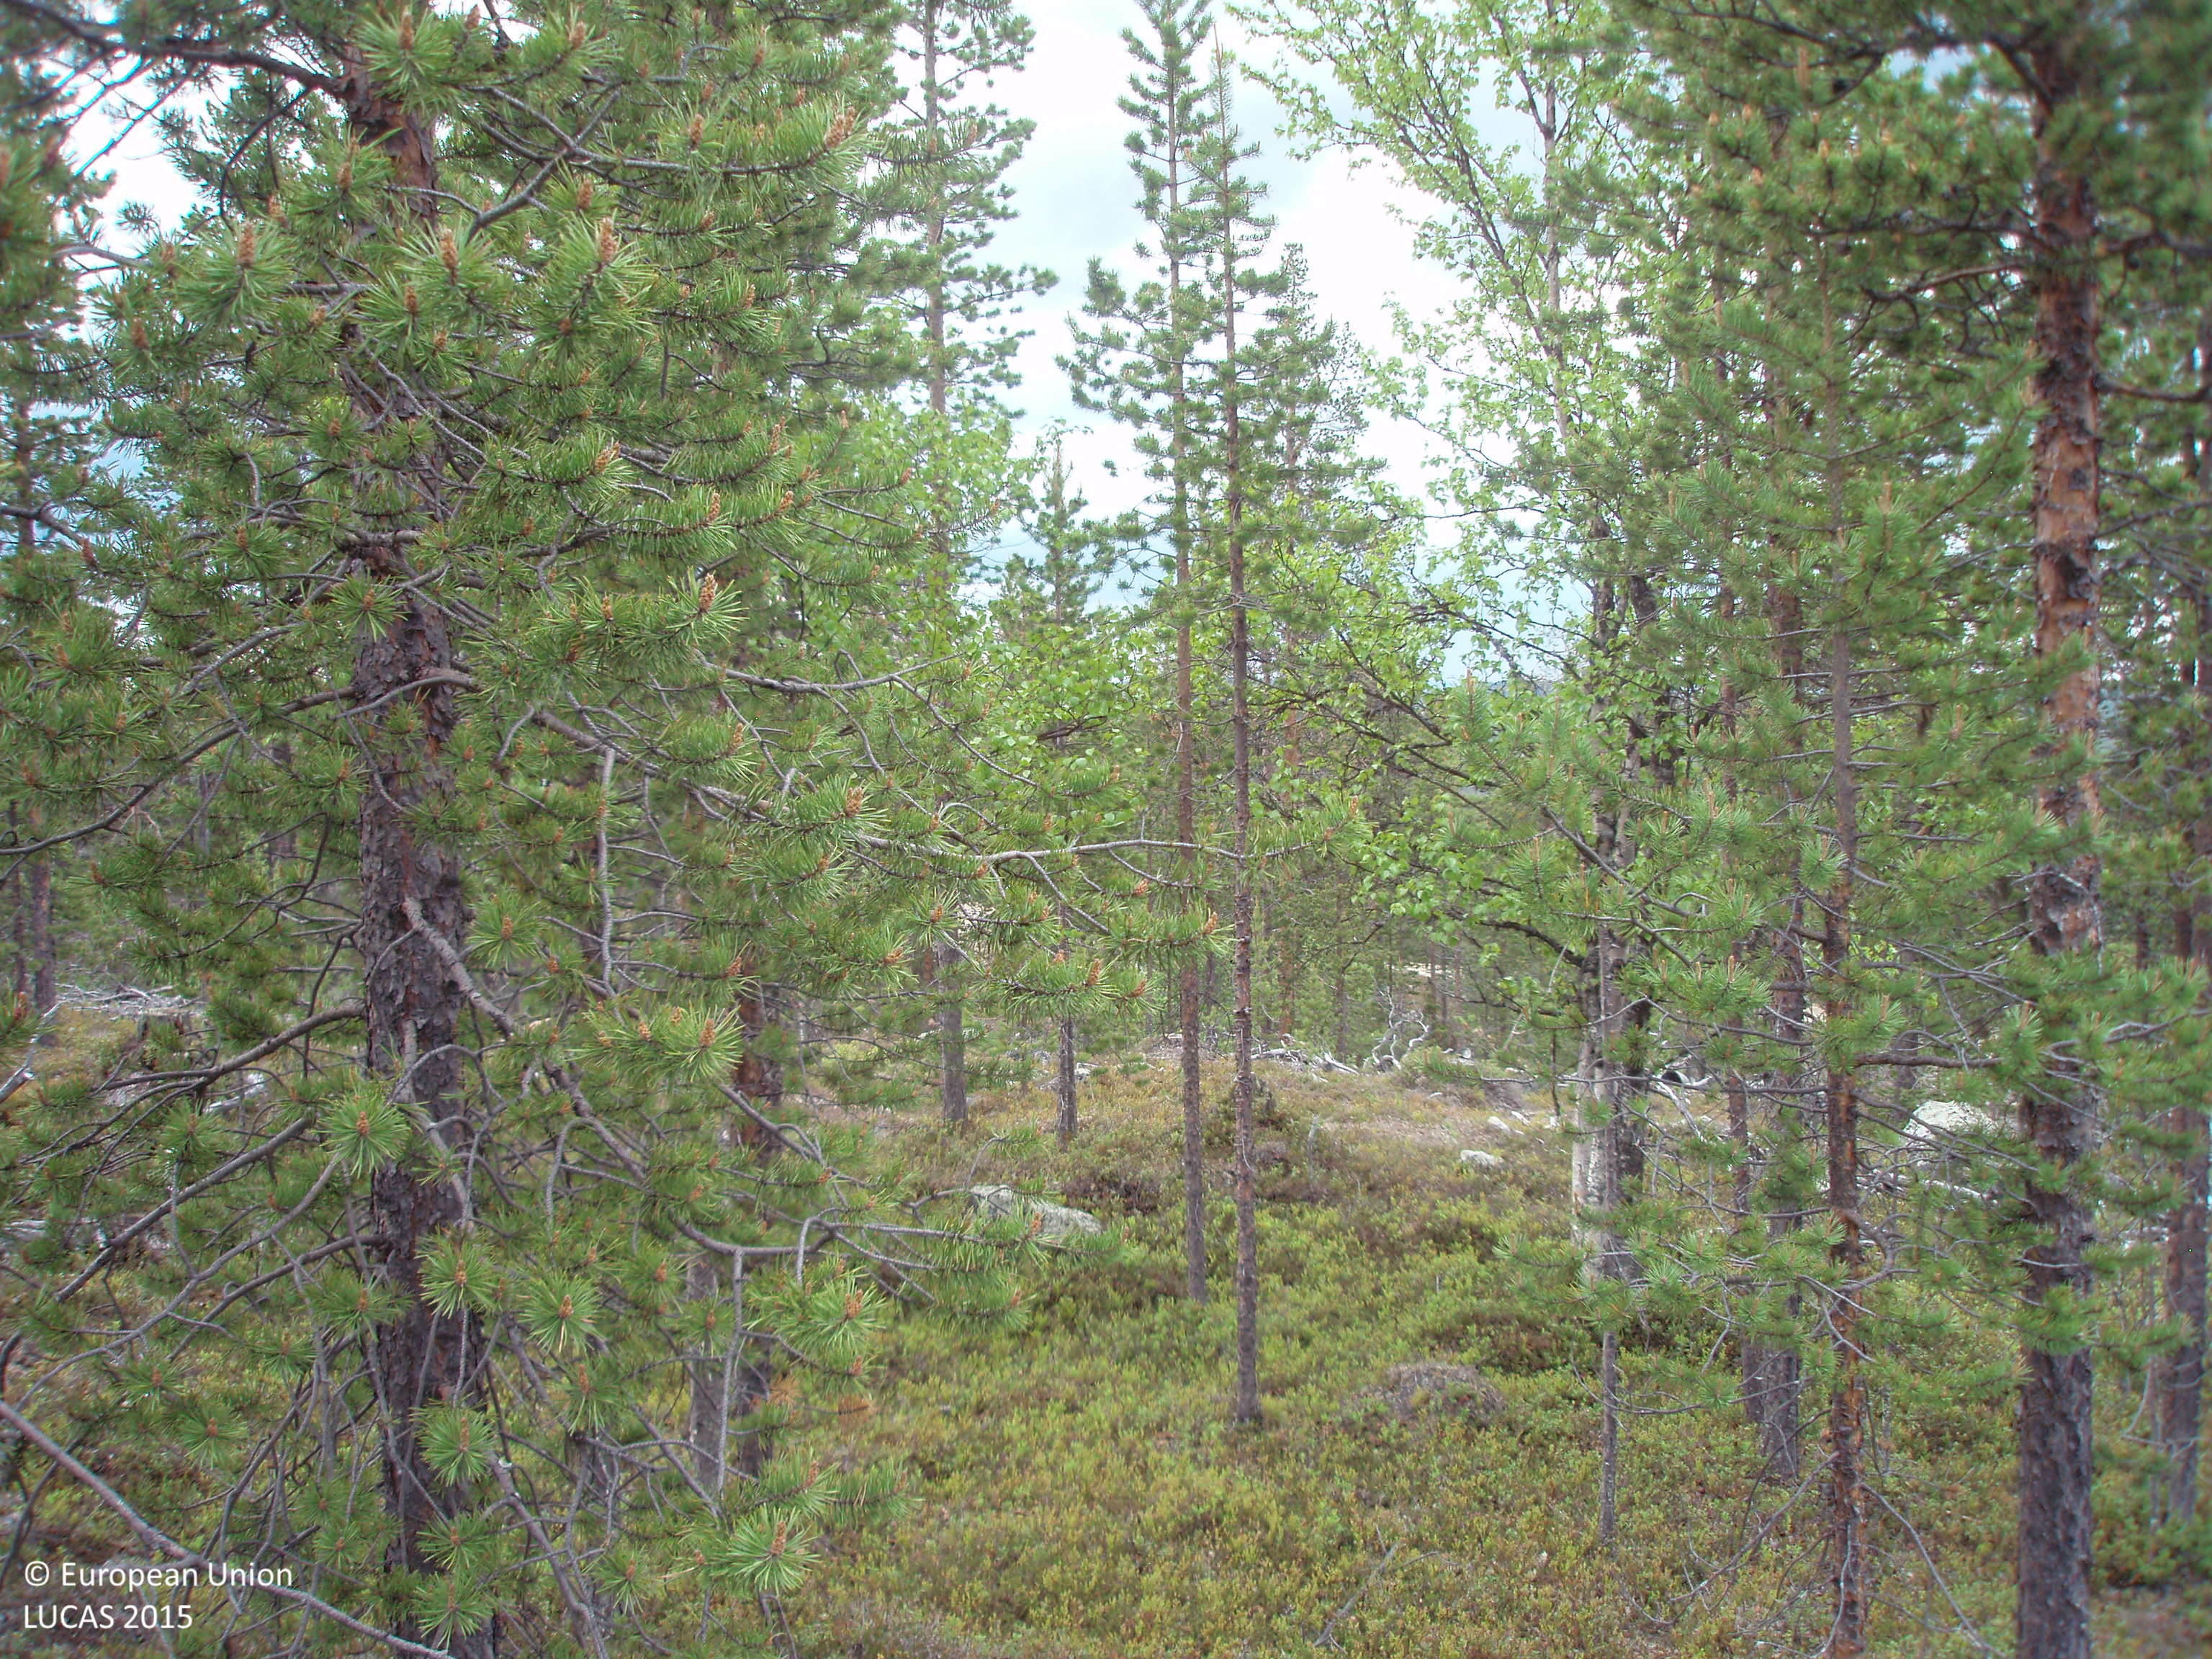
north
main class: Woodland
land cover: Pine dominated coniferous woodland
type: boreal forest
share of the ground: 50 - 75 %
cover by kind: coniferous forest trees 45 %, shrubs 30 %, broadleaved forest trees 15 %, lichens and mosses 10 %
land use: Forestry
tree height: > 5 m
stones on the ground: > 50 %
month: June
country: FI
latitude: 68.8315
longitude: 27.2635
